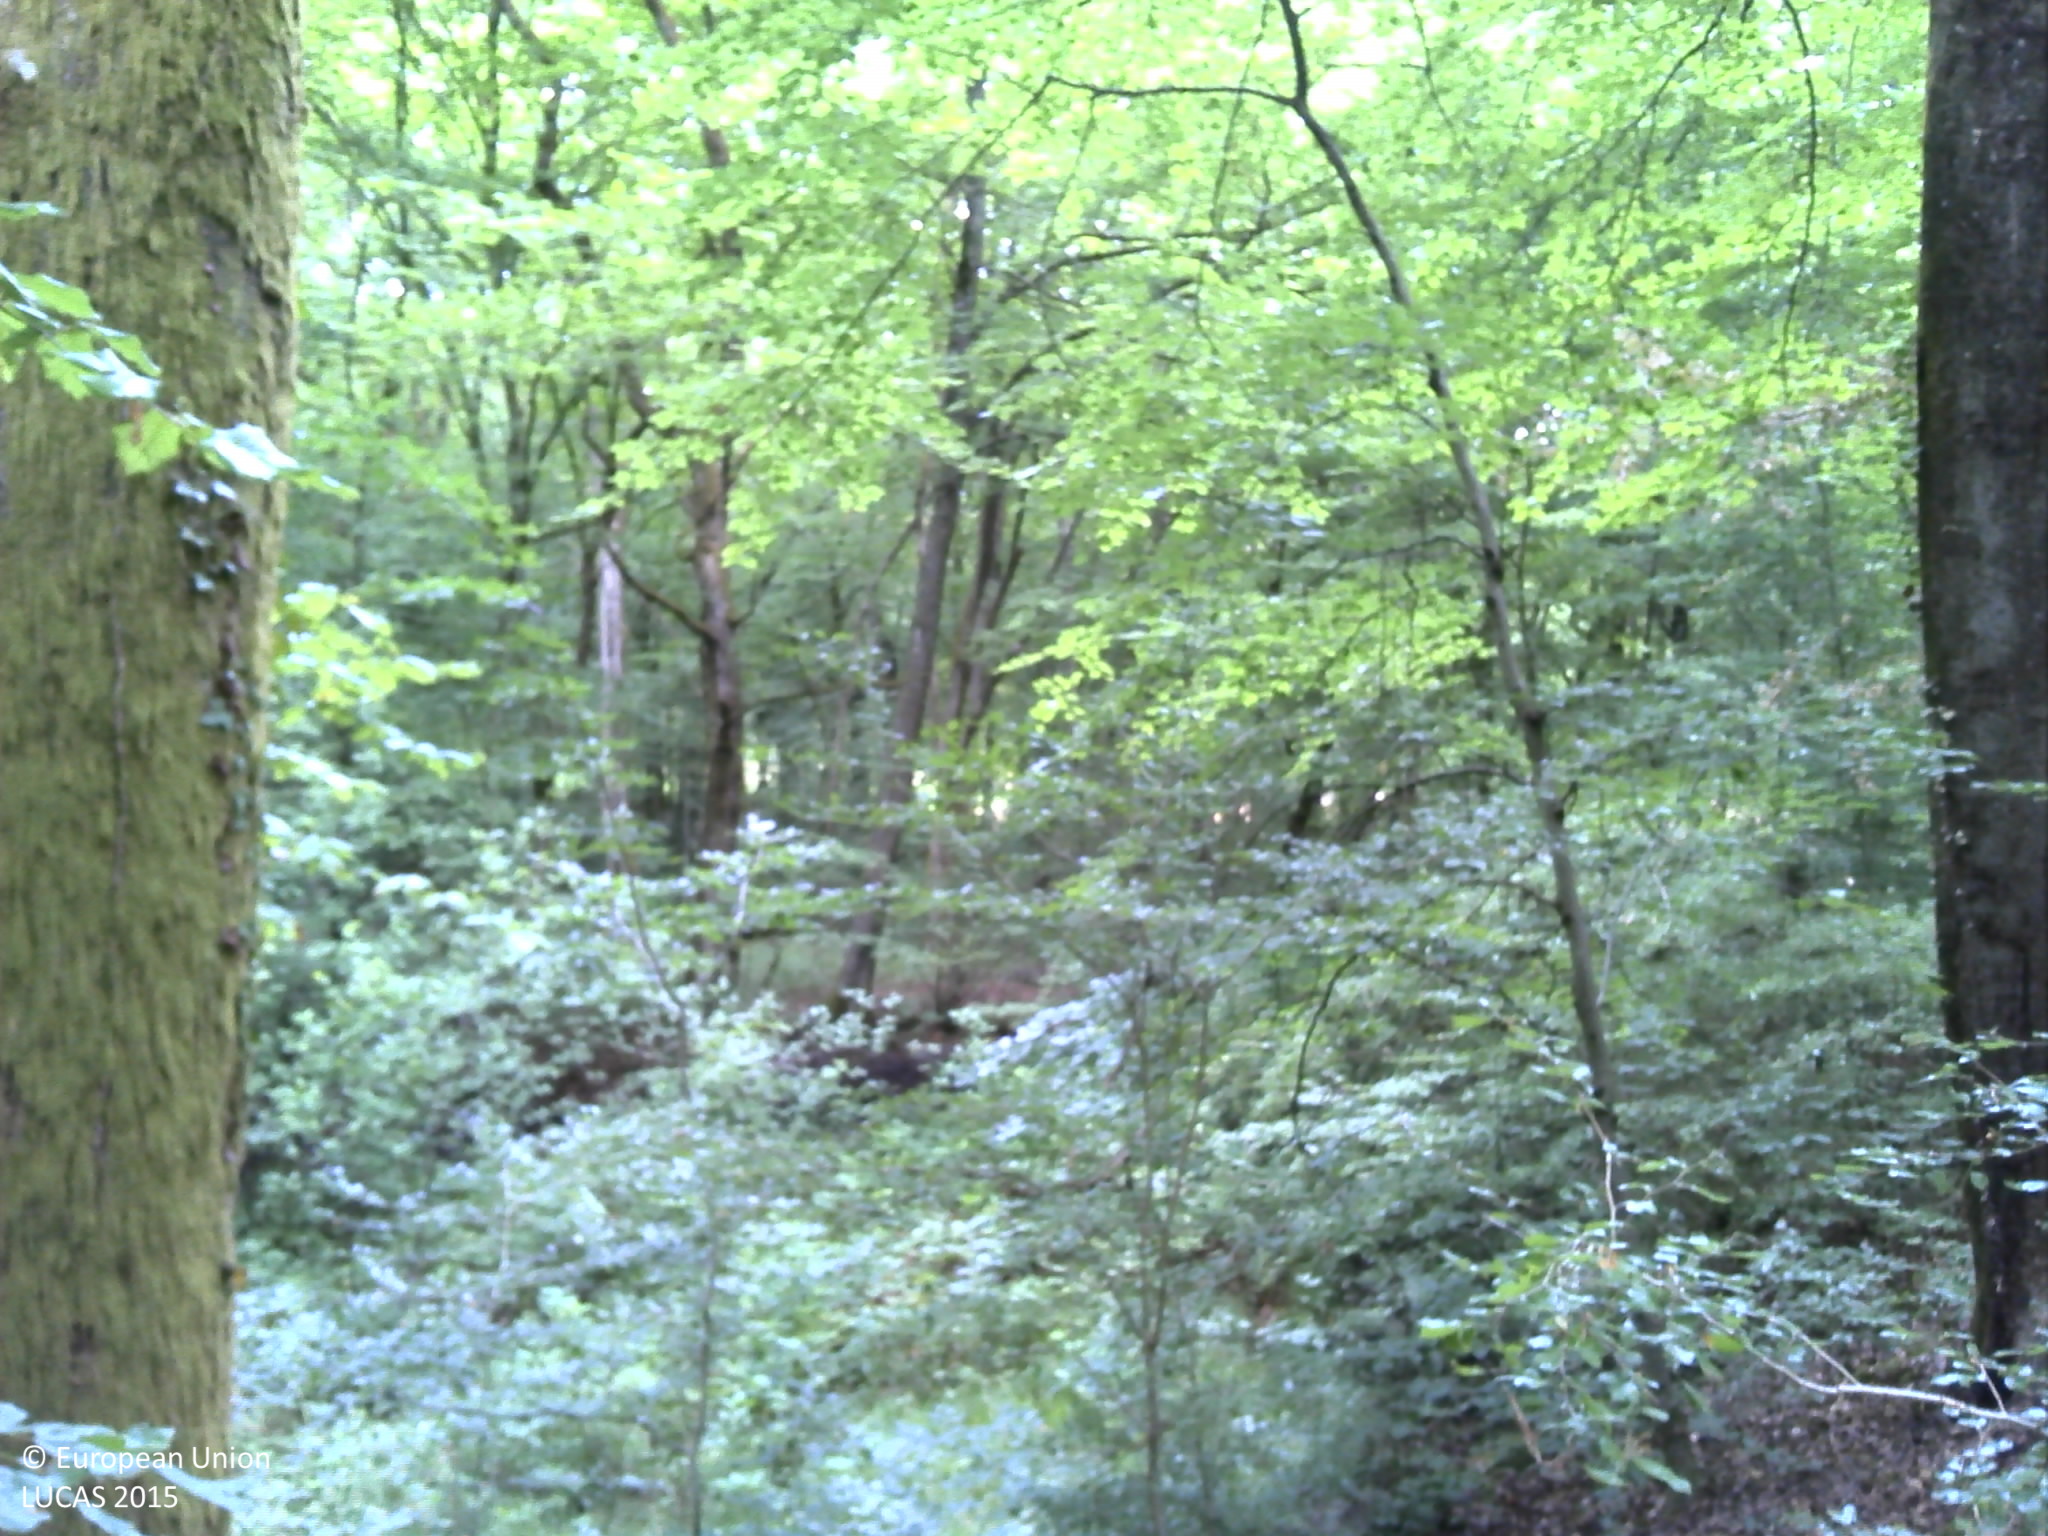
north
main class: Woodland
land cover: Broadleaved woodland
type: acidophilous oak and oak-birch forest
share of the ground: > 75 %
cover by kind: broadleaved forest trees 90 %, herbaceous plants 10 %
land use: Forestry
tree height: > 5 m
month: July
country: FR
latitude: 49.3023
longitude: 6.4930
